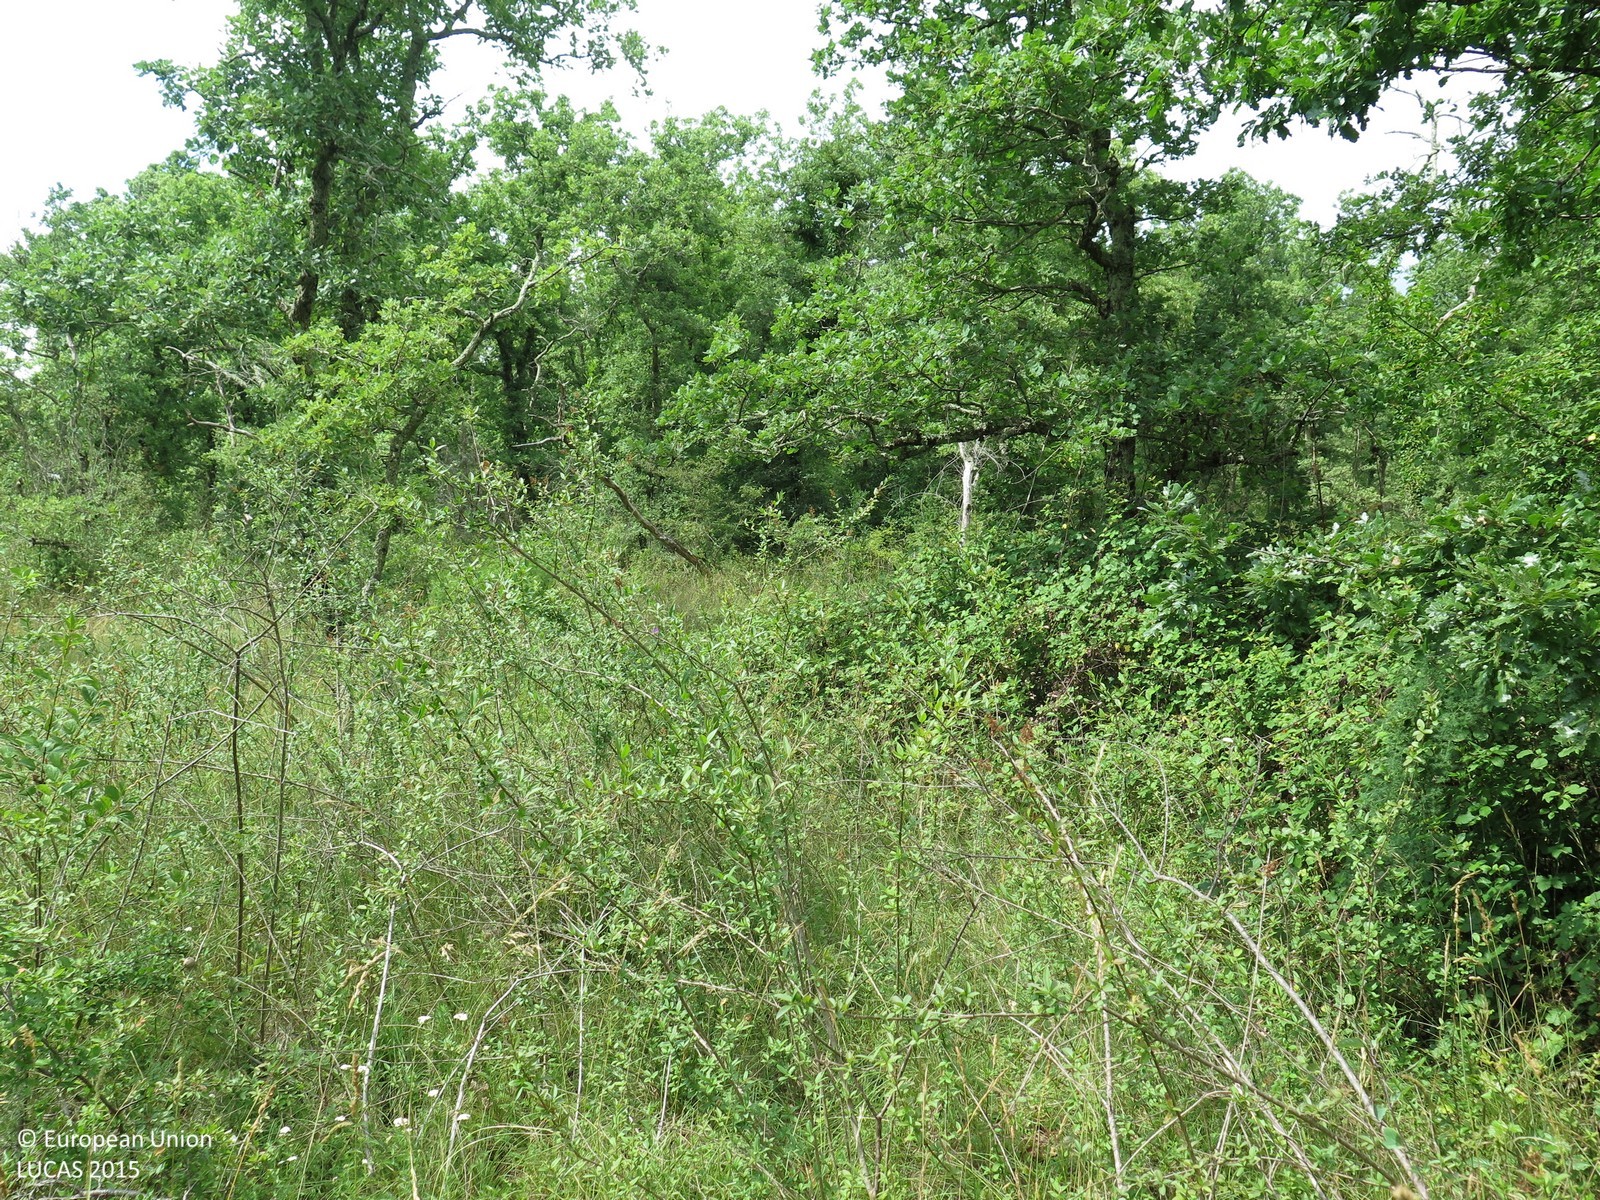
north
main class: Shrubland
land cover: Shrubland with sparse tree cover
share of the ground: > 75 %
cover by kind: shrubs 90 %, broadleaved forest trees 5 %, herbaceous plants 5 %
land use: Semi-natural and natural areas not in use
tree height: > 5 m
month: June
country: HR
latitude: 45.2753
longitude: 13.7553
